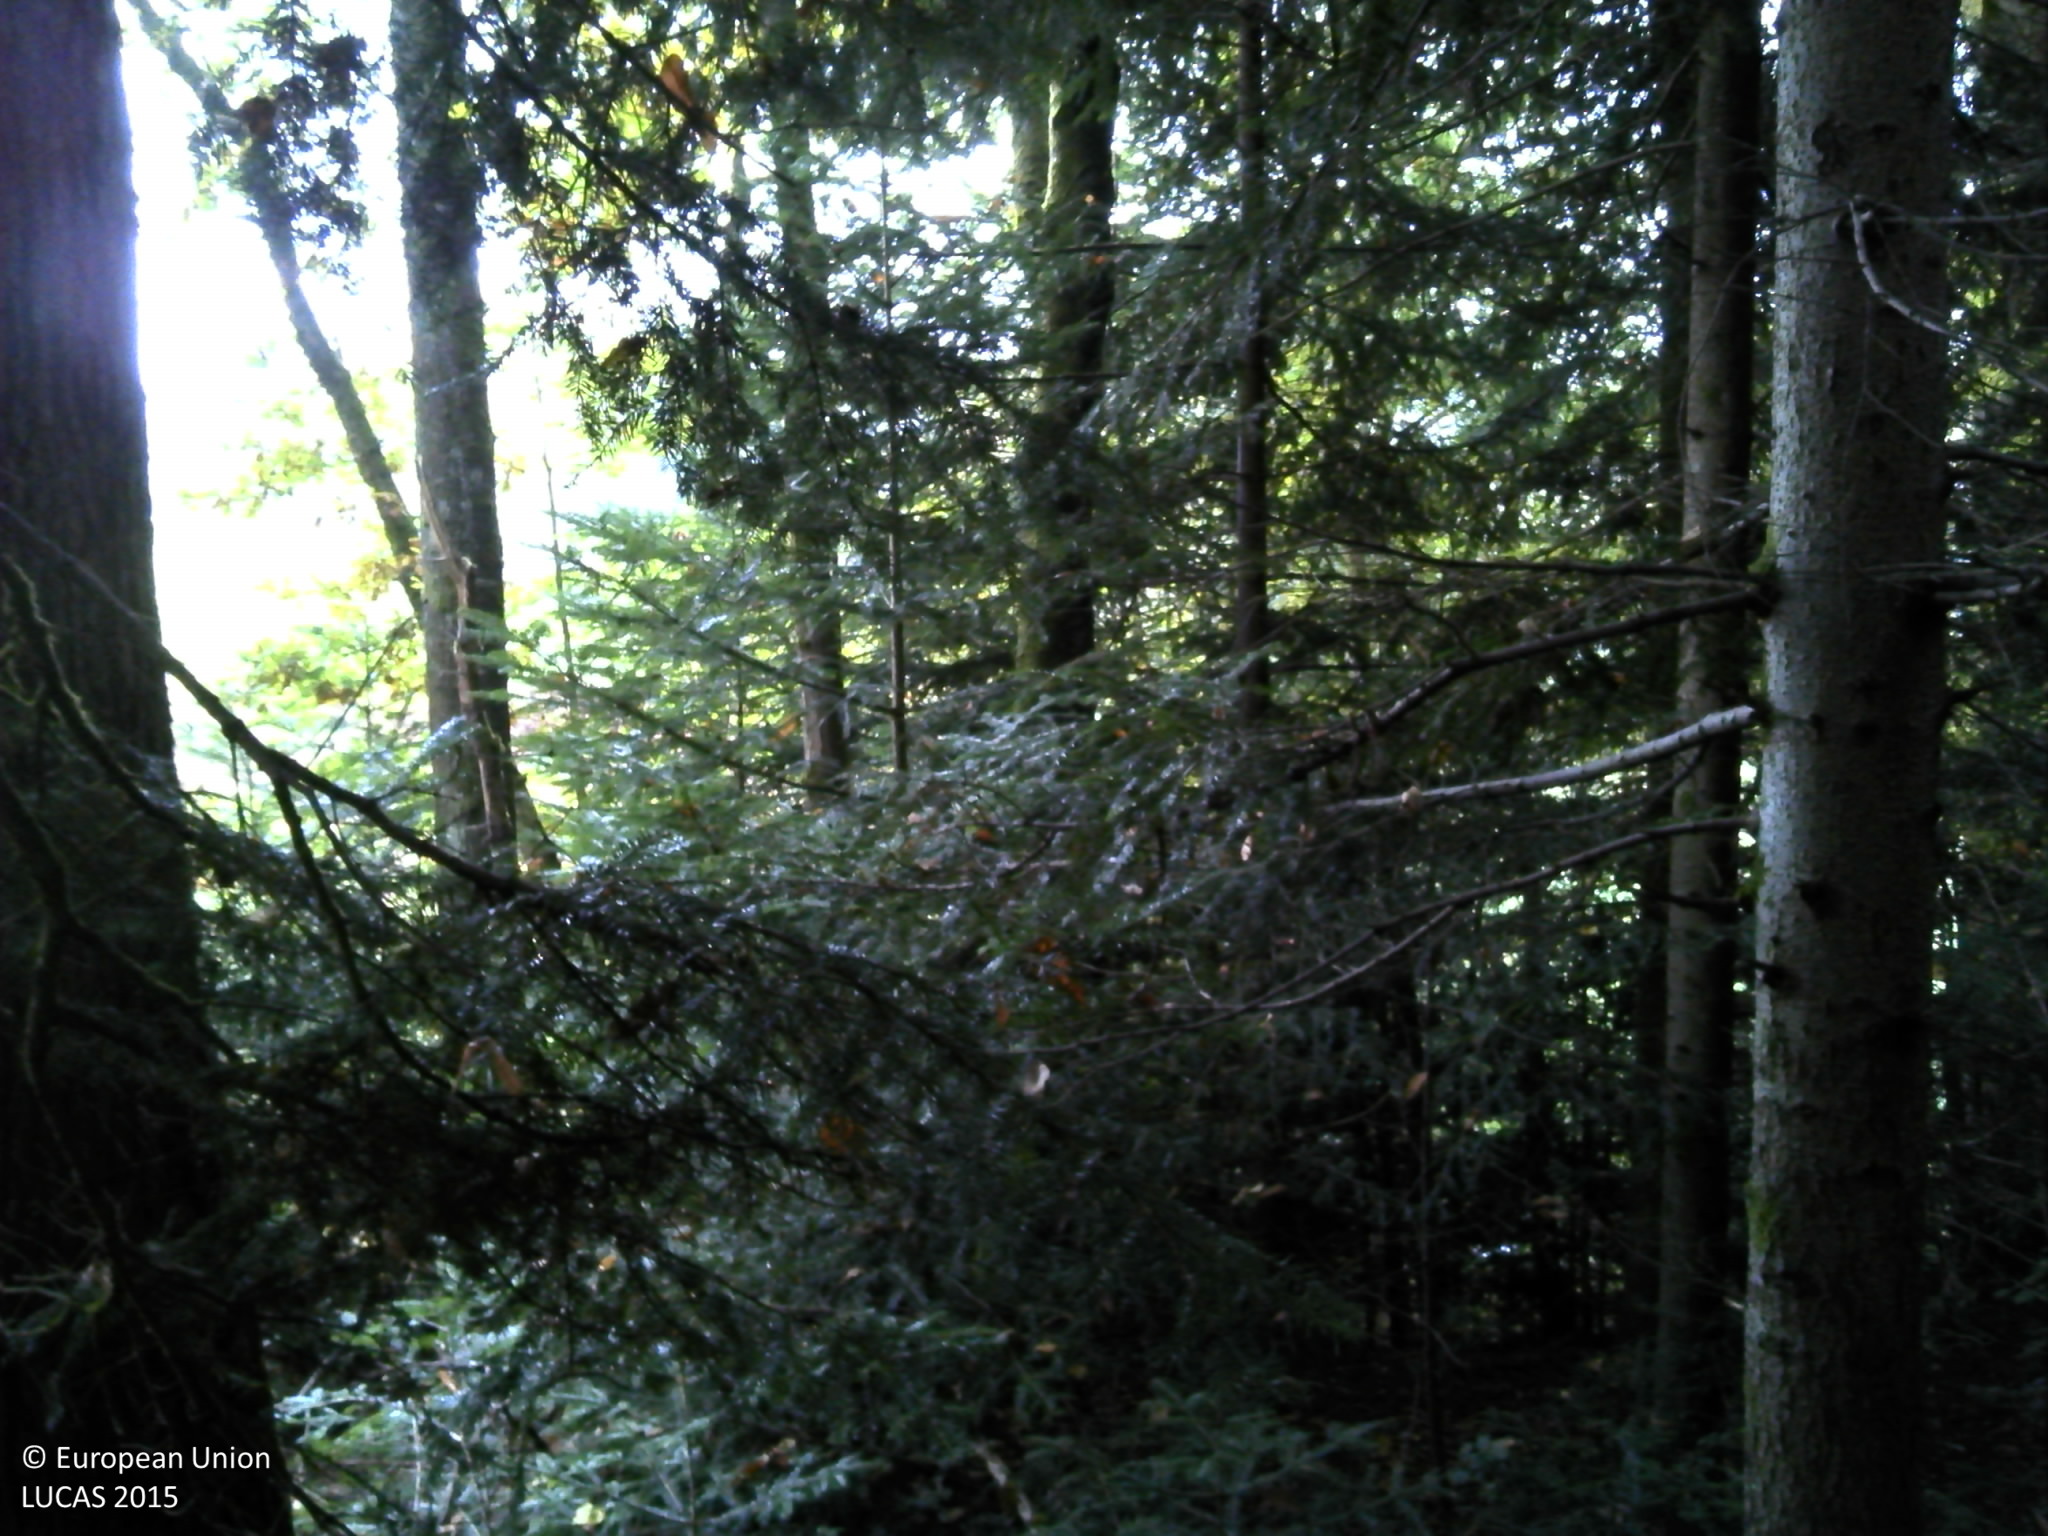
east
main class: Woodland
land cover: Spruce dominated mixed woodland
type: acidophilous oak and oak-birch forest
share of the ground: > 75 %
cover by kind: coniferous forest trees 60 %, broadleaved forest trees 30 %, unconsolidated bare surface 10 %
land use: Forestry
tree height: > 5 m
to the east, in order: Spruce dominated mixed woodland; Fences; Grassland without tree/shrub cover; Spontaneously vegetated surfaces; Fences; Grassland with sparse tree/shrub cover; Broadleaved woodland; Rivers and streams; Broadleaved woodland; Shrubland without tree cover; Spontaneously vegetated surfaces; Spruce dominated coniferous woodland
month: October
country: FR
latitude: 45.6596
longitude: 3.7004
